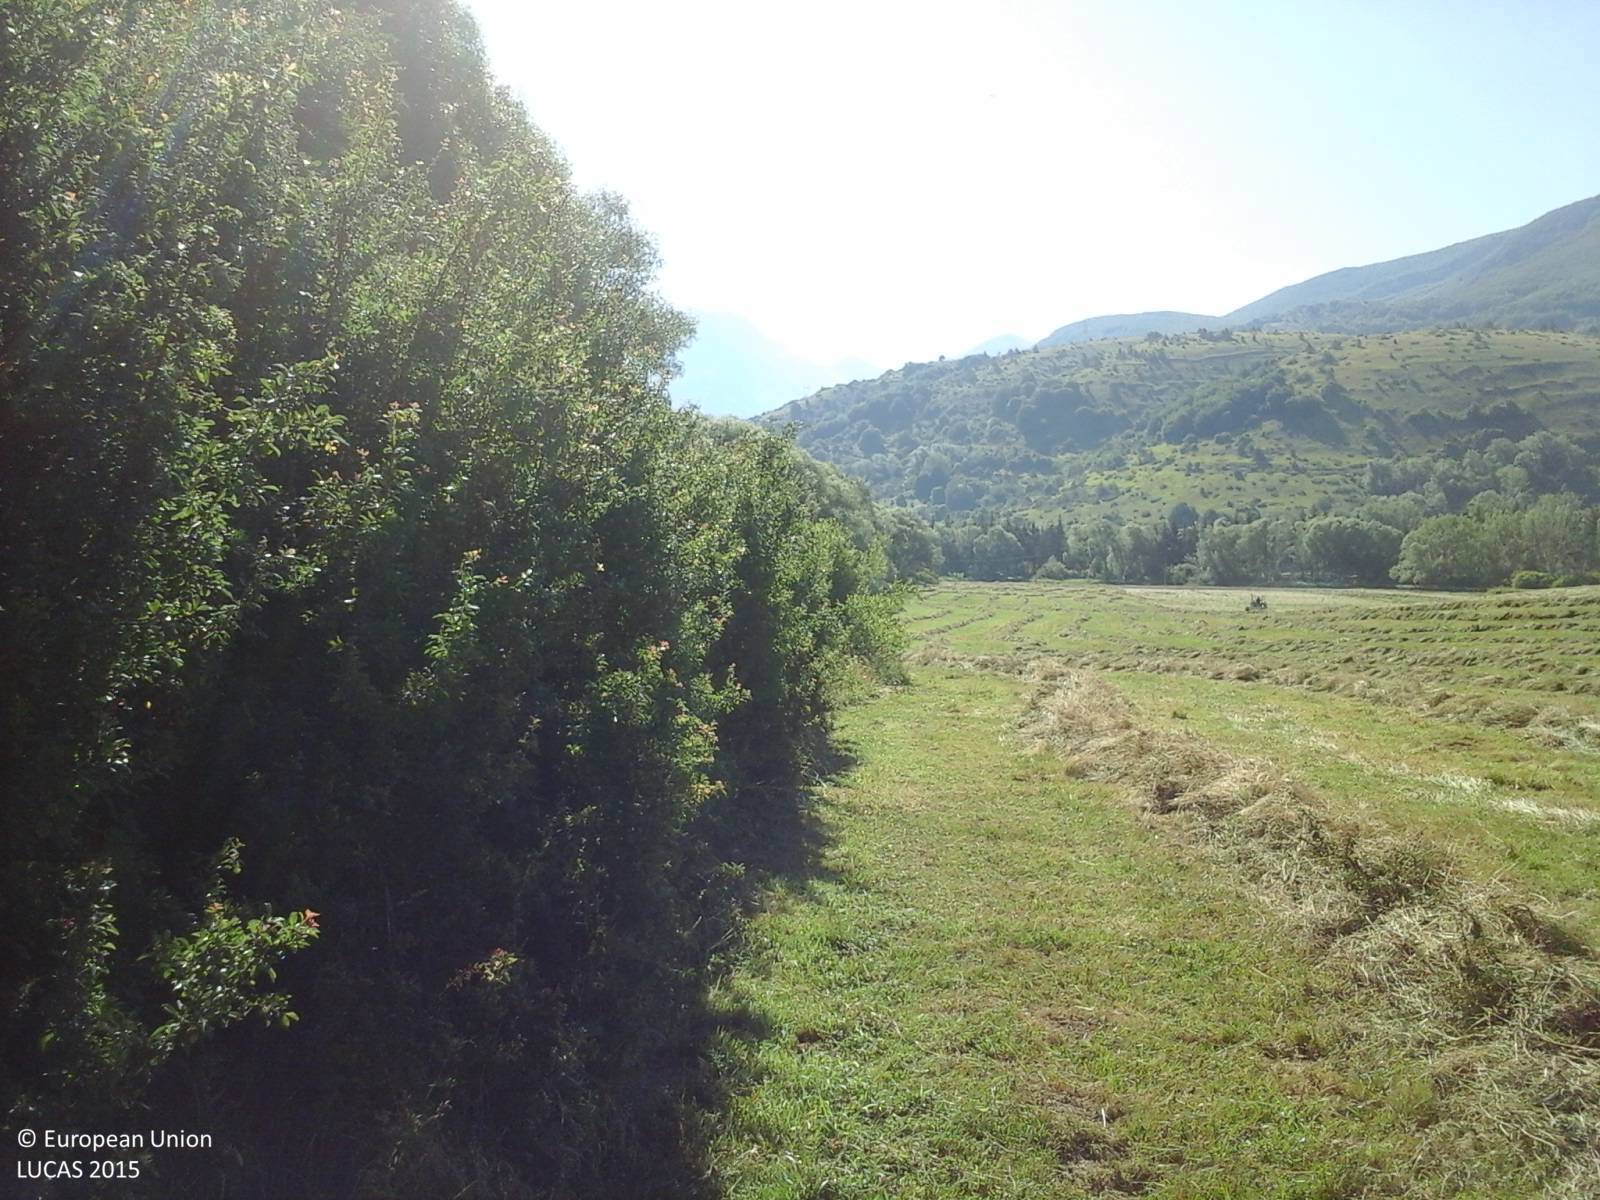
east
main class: Shrubland
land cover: Shrubland without tree cover
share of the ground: > 75 %
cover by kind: shrubs 100 %
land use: Semi-natural and natural areas not in use
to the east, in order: Shrubland without tree cover; Broadleaved woodland; Rivers and streams; Broadleaved woodland; Grassland without tree/shrub cover; Electric lines; Grassland without tree/shrub cover
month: July
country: IT
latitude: 42.4899
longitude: 13.3596
